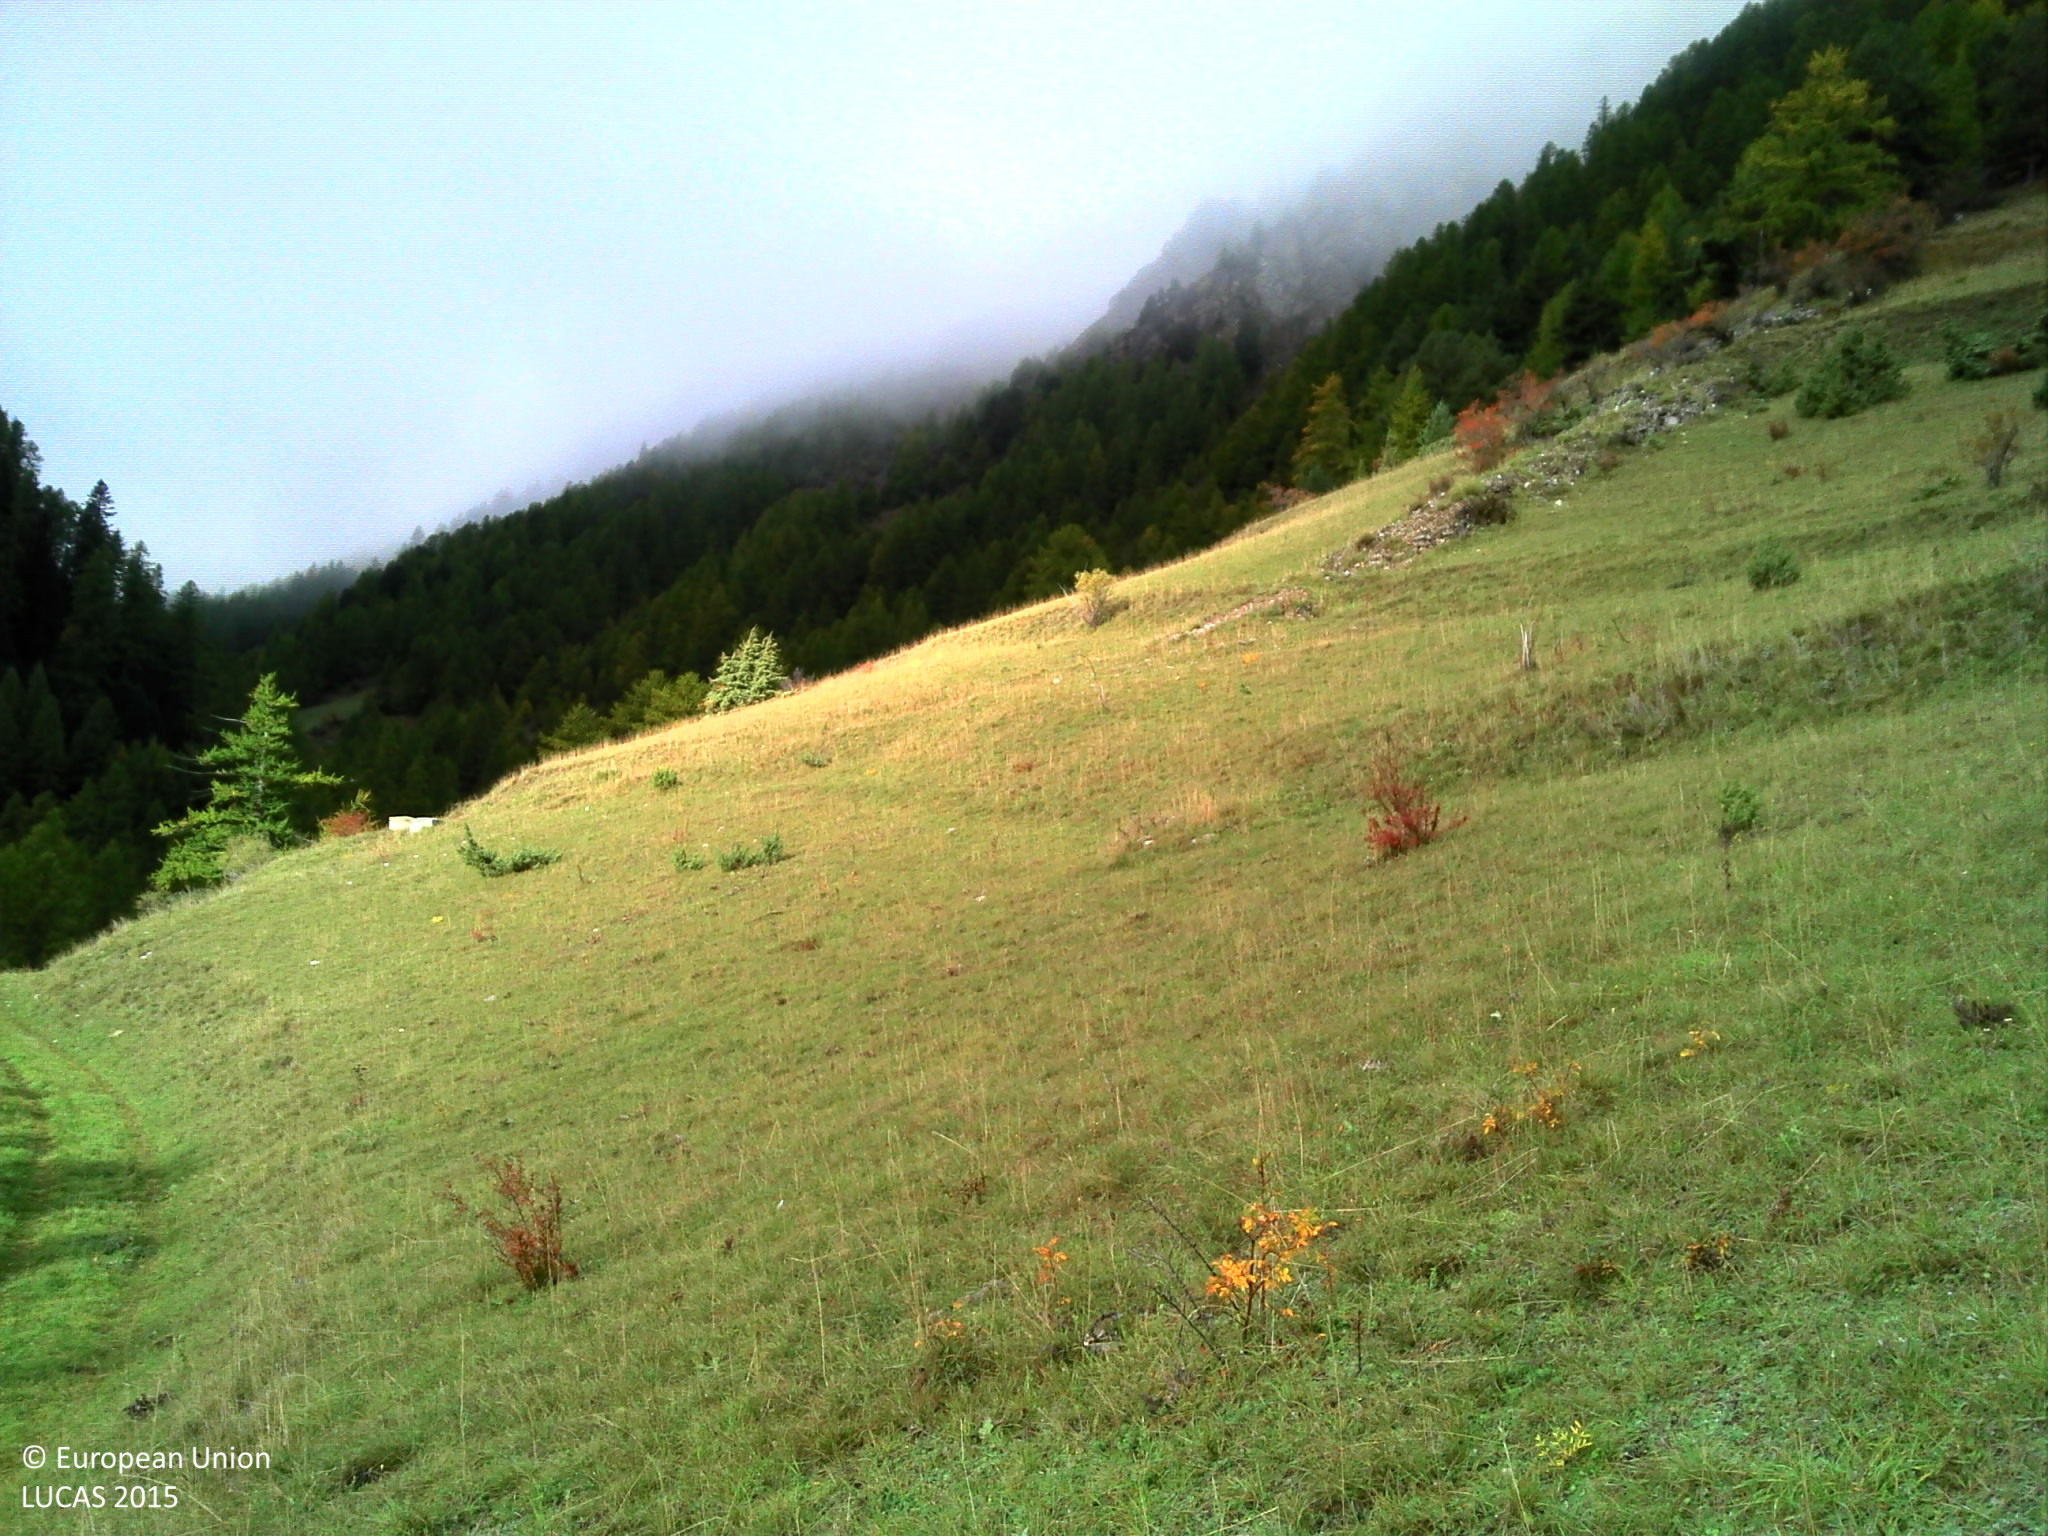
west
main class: Grassland
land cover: Grassland without tree/shrub cover
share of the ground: > 75 %
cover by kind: herbaceous plants 90 %, shrubs 5 %, consolidated bare surface 5 %
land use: Agriculture (excluding fallow land and kitchen gardens)
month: October
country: FR
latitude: 44.7684
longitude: 6.7332
